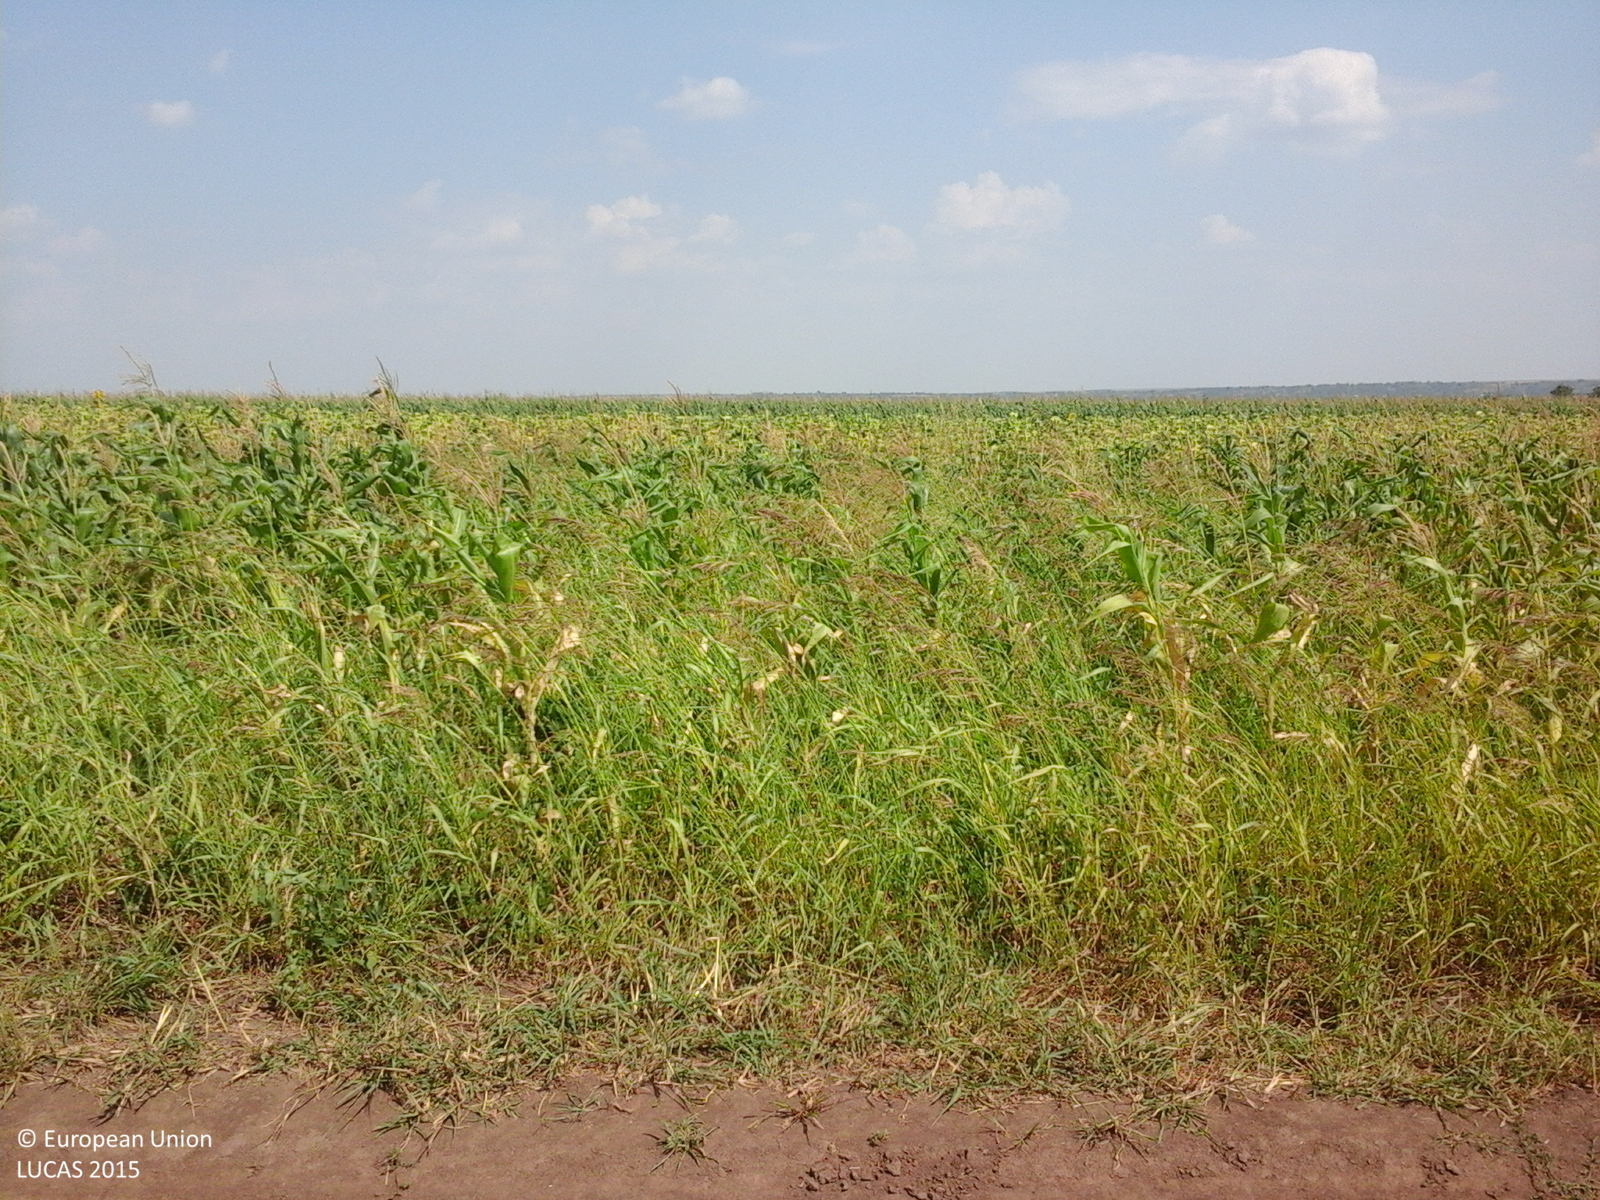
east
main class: Cropland
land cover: Sunflower
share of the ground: > 75 %
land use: Agriculture (excluding fallow land and kitchen gardens)
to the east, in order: Sunflower; Grass margins; Tracks; Grass margins; Maize; Sunflower; Maize
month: July
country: RO
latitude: 45.9122
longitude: 27.5770
